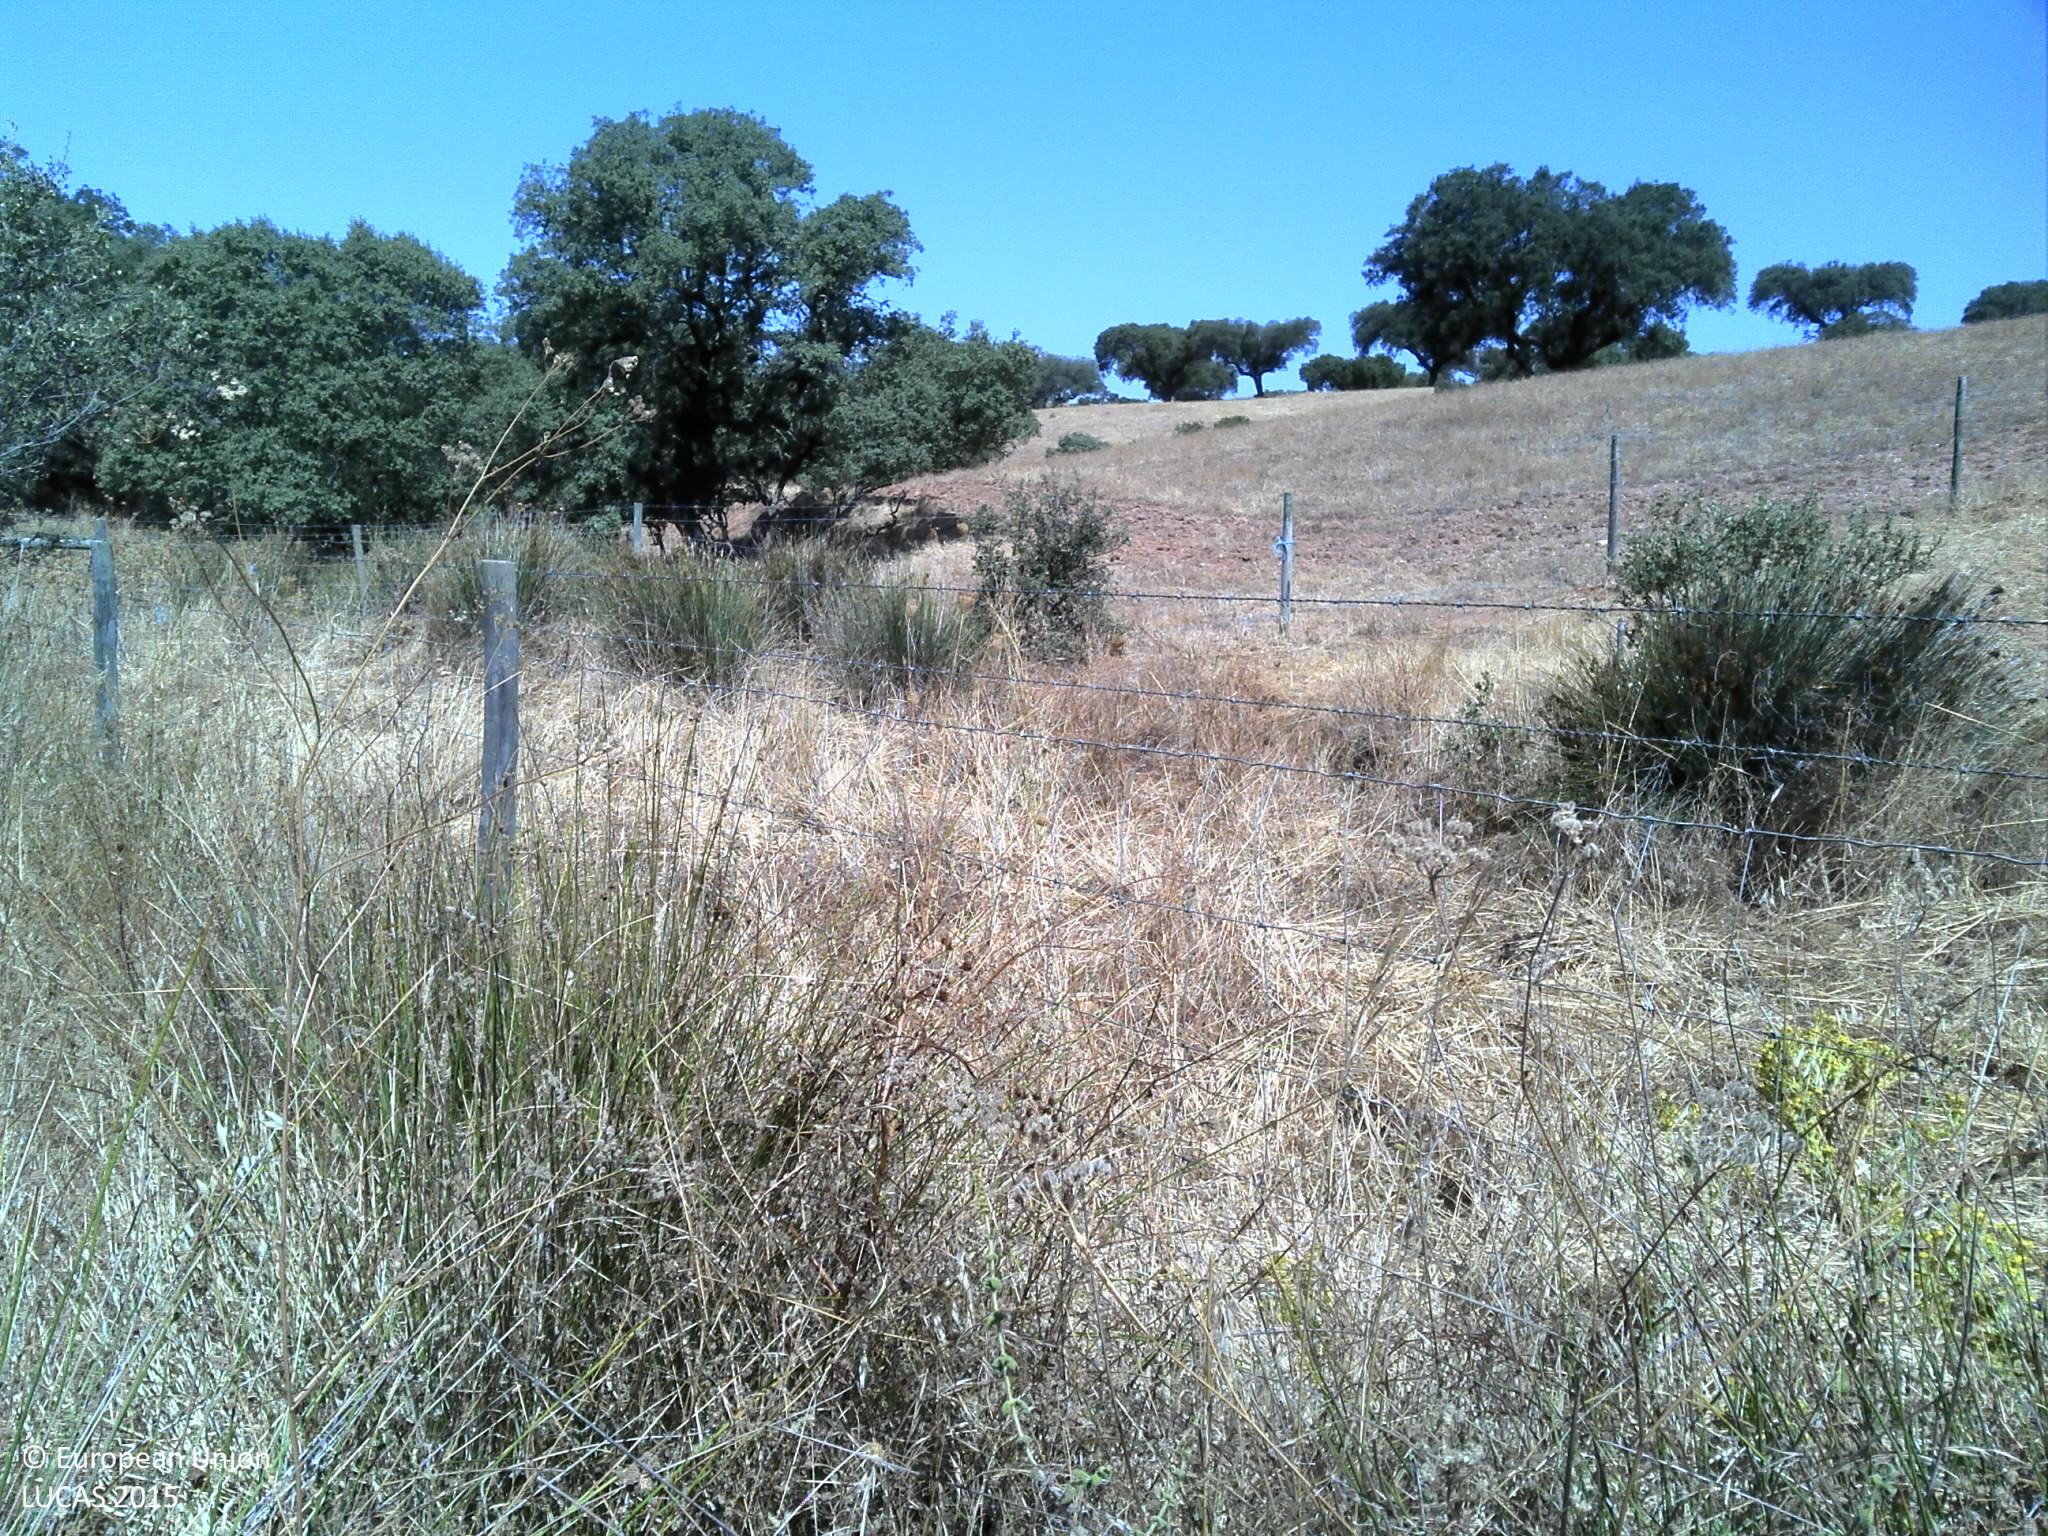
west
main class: Grassland
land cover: Grassland without tree/shrub cover
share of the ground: > 75 %
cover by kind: herbaceous plants 85 %, unconsolidated bare surface 15 %
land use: Agriculture (excluding fallow land and kitchen gardens)
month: August
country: PT
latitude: 37.8820
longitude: -7.8176
